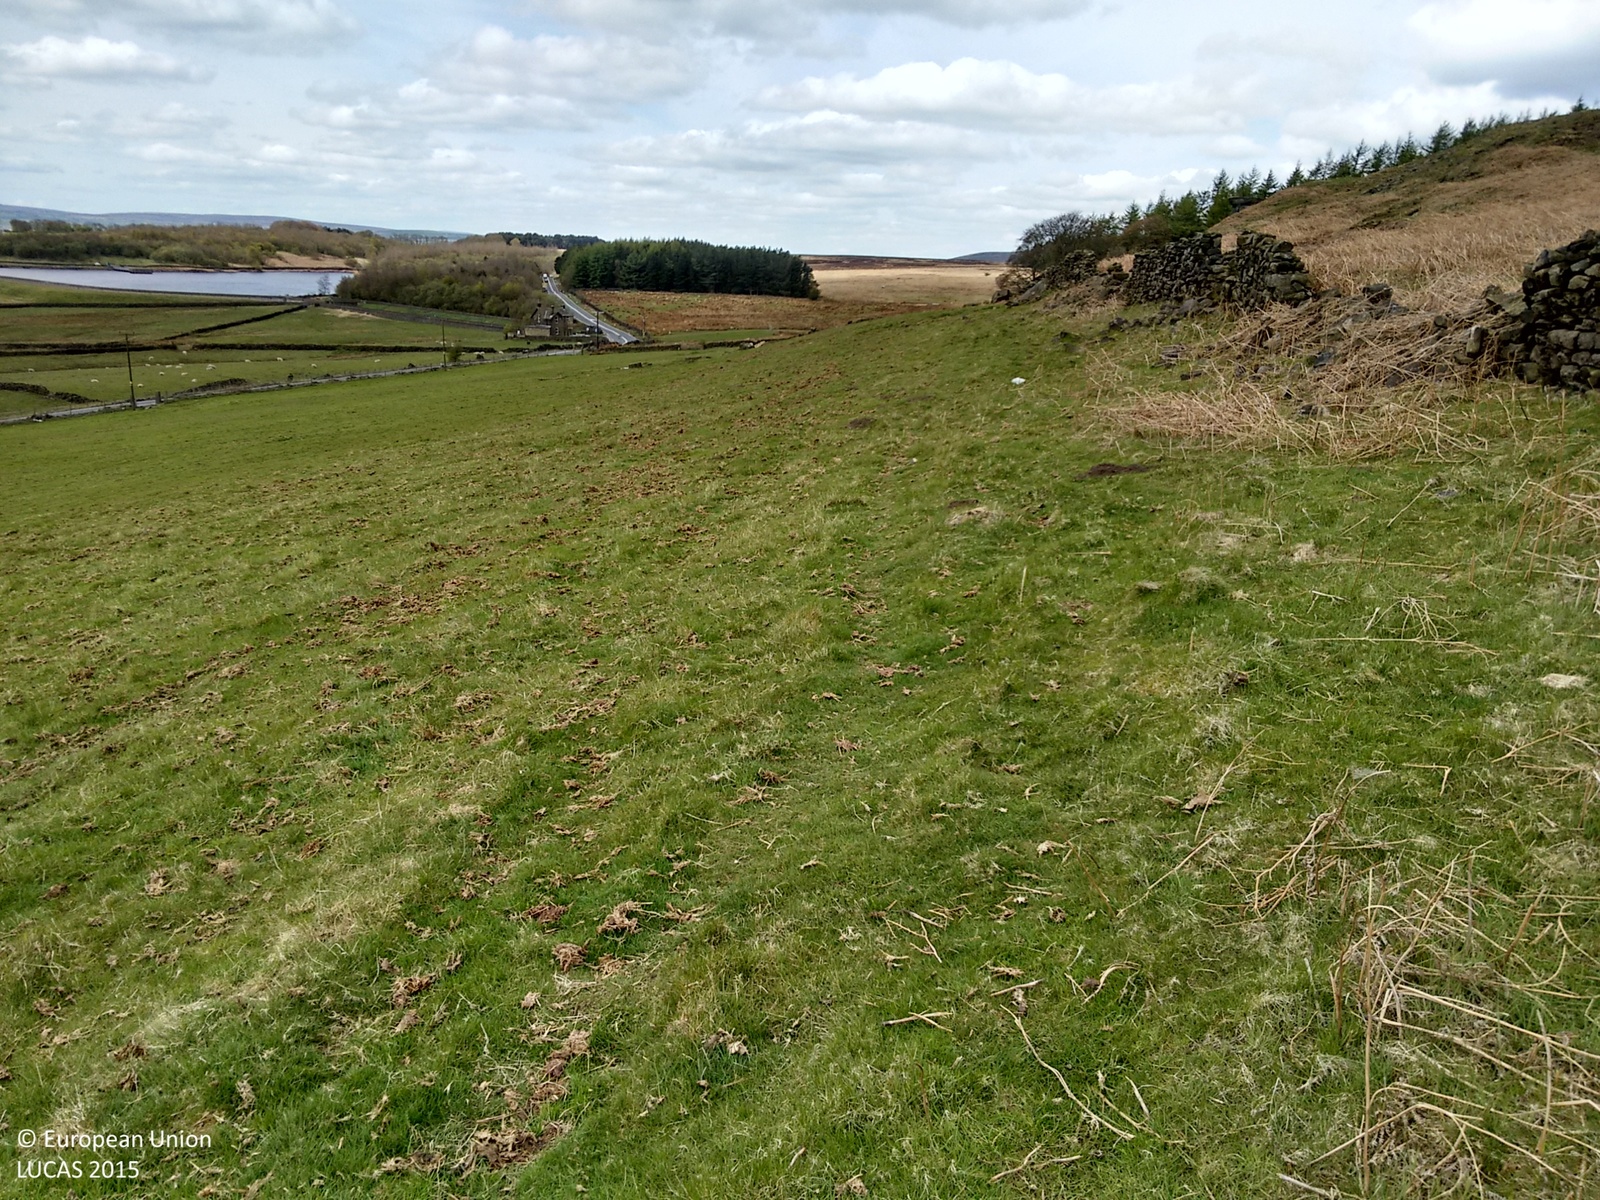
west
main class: Grassland
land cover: Grassland without tree/shrub cover
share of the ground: > 75 %
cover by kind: herbaceous plants 100 %
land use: Agriculture (excluding fallow land and kitchen gardens)
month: May
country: GB
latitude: 53.8759
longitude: -1.8117
